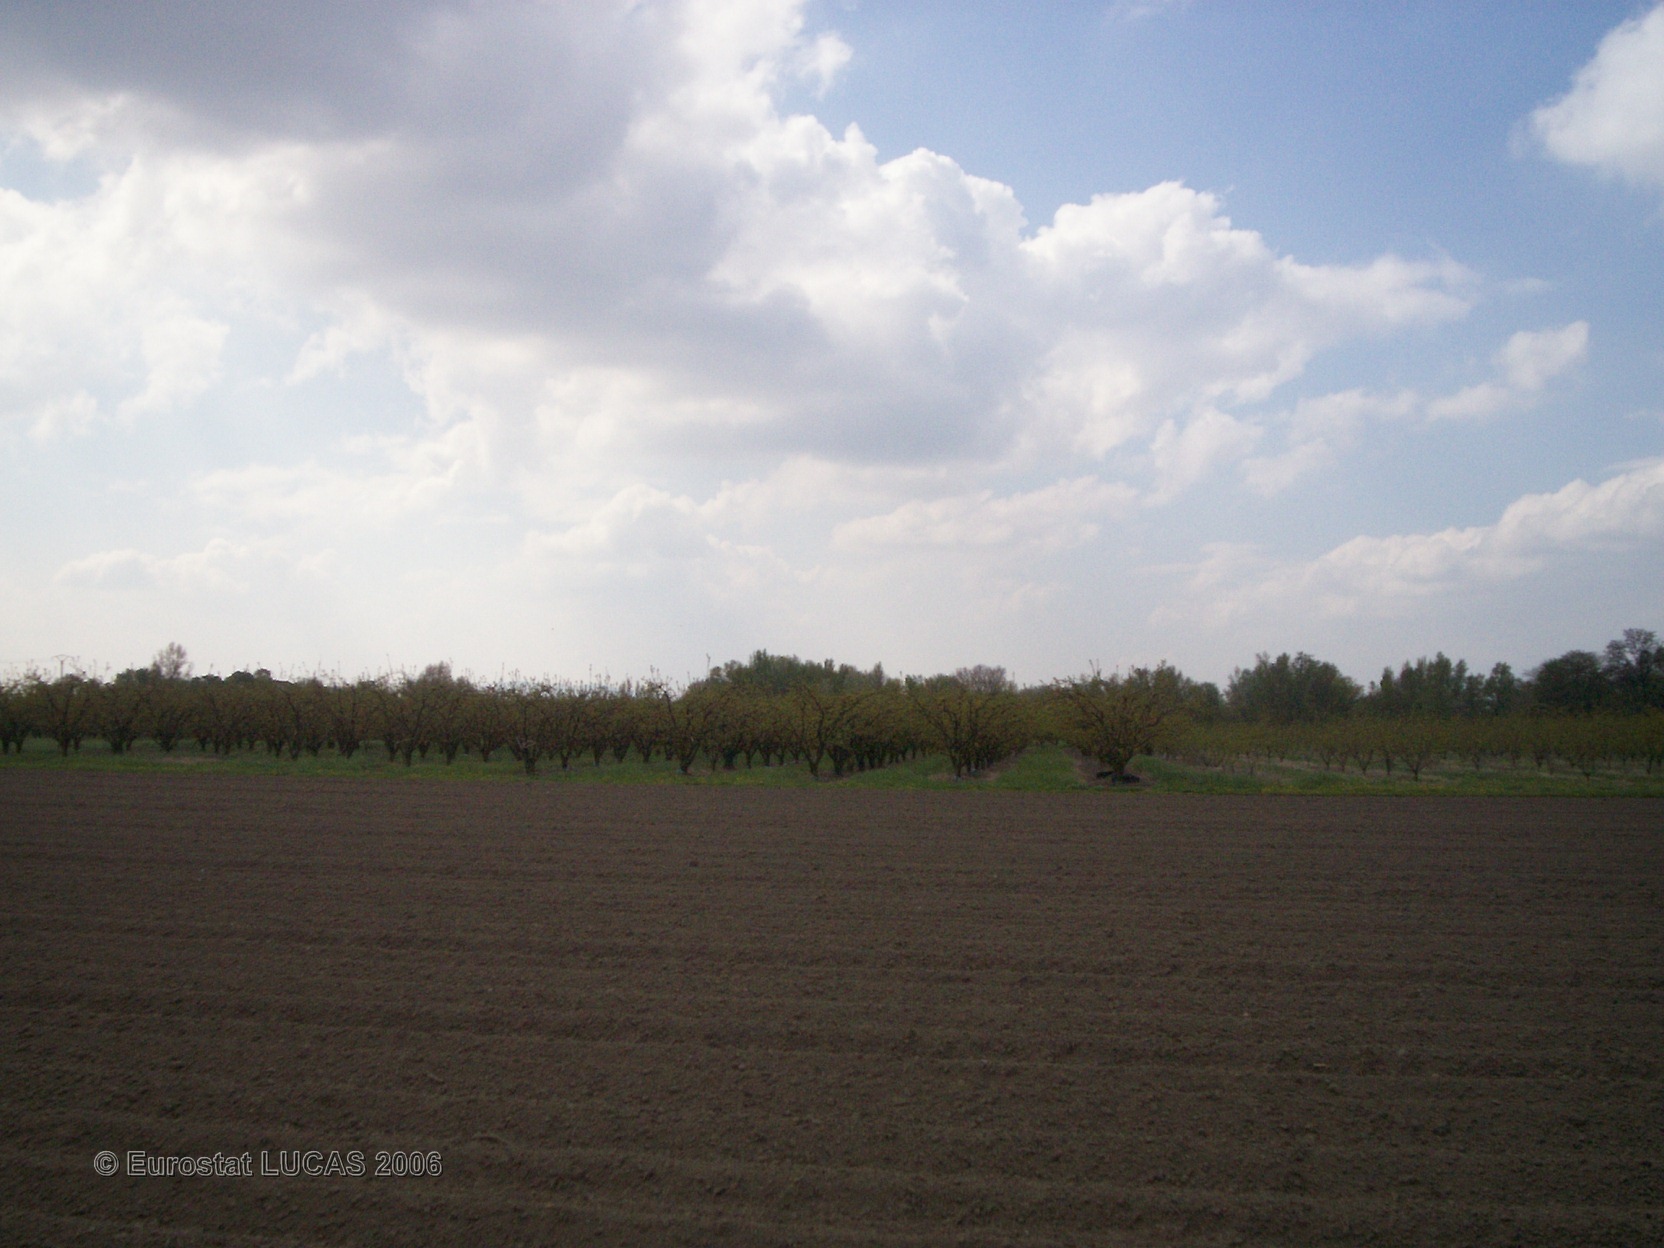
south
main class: Cropland
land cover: Potatoes
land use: Agriculture (excluding fallow land and kitchen gardens)
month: June
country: FR
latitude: 44.8553
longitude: 4.8557
